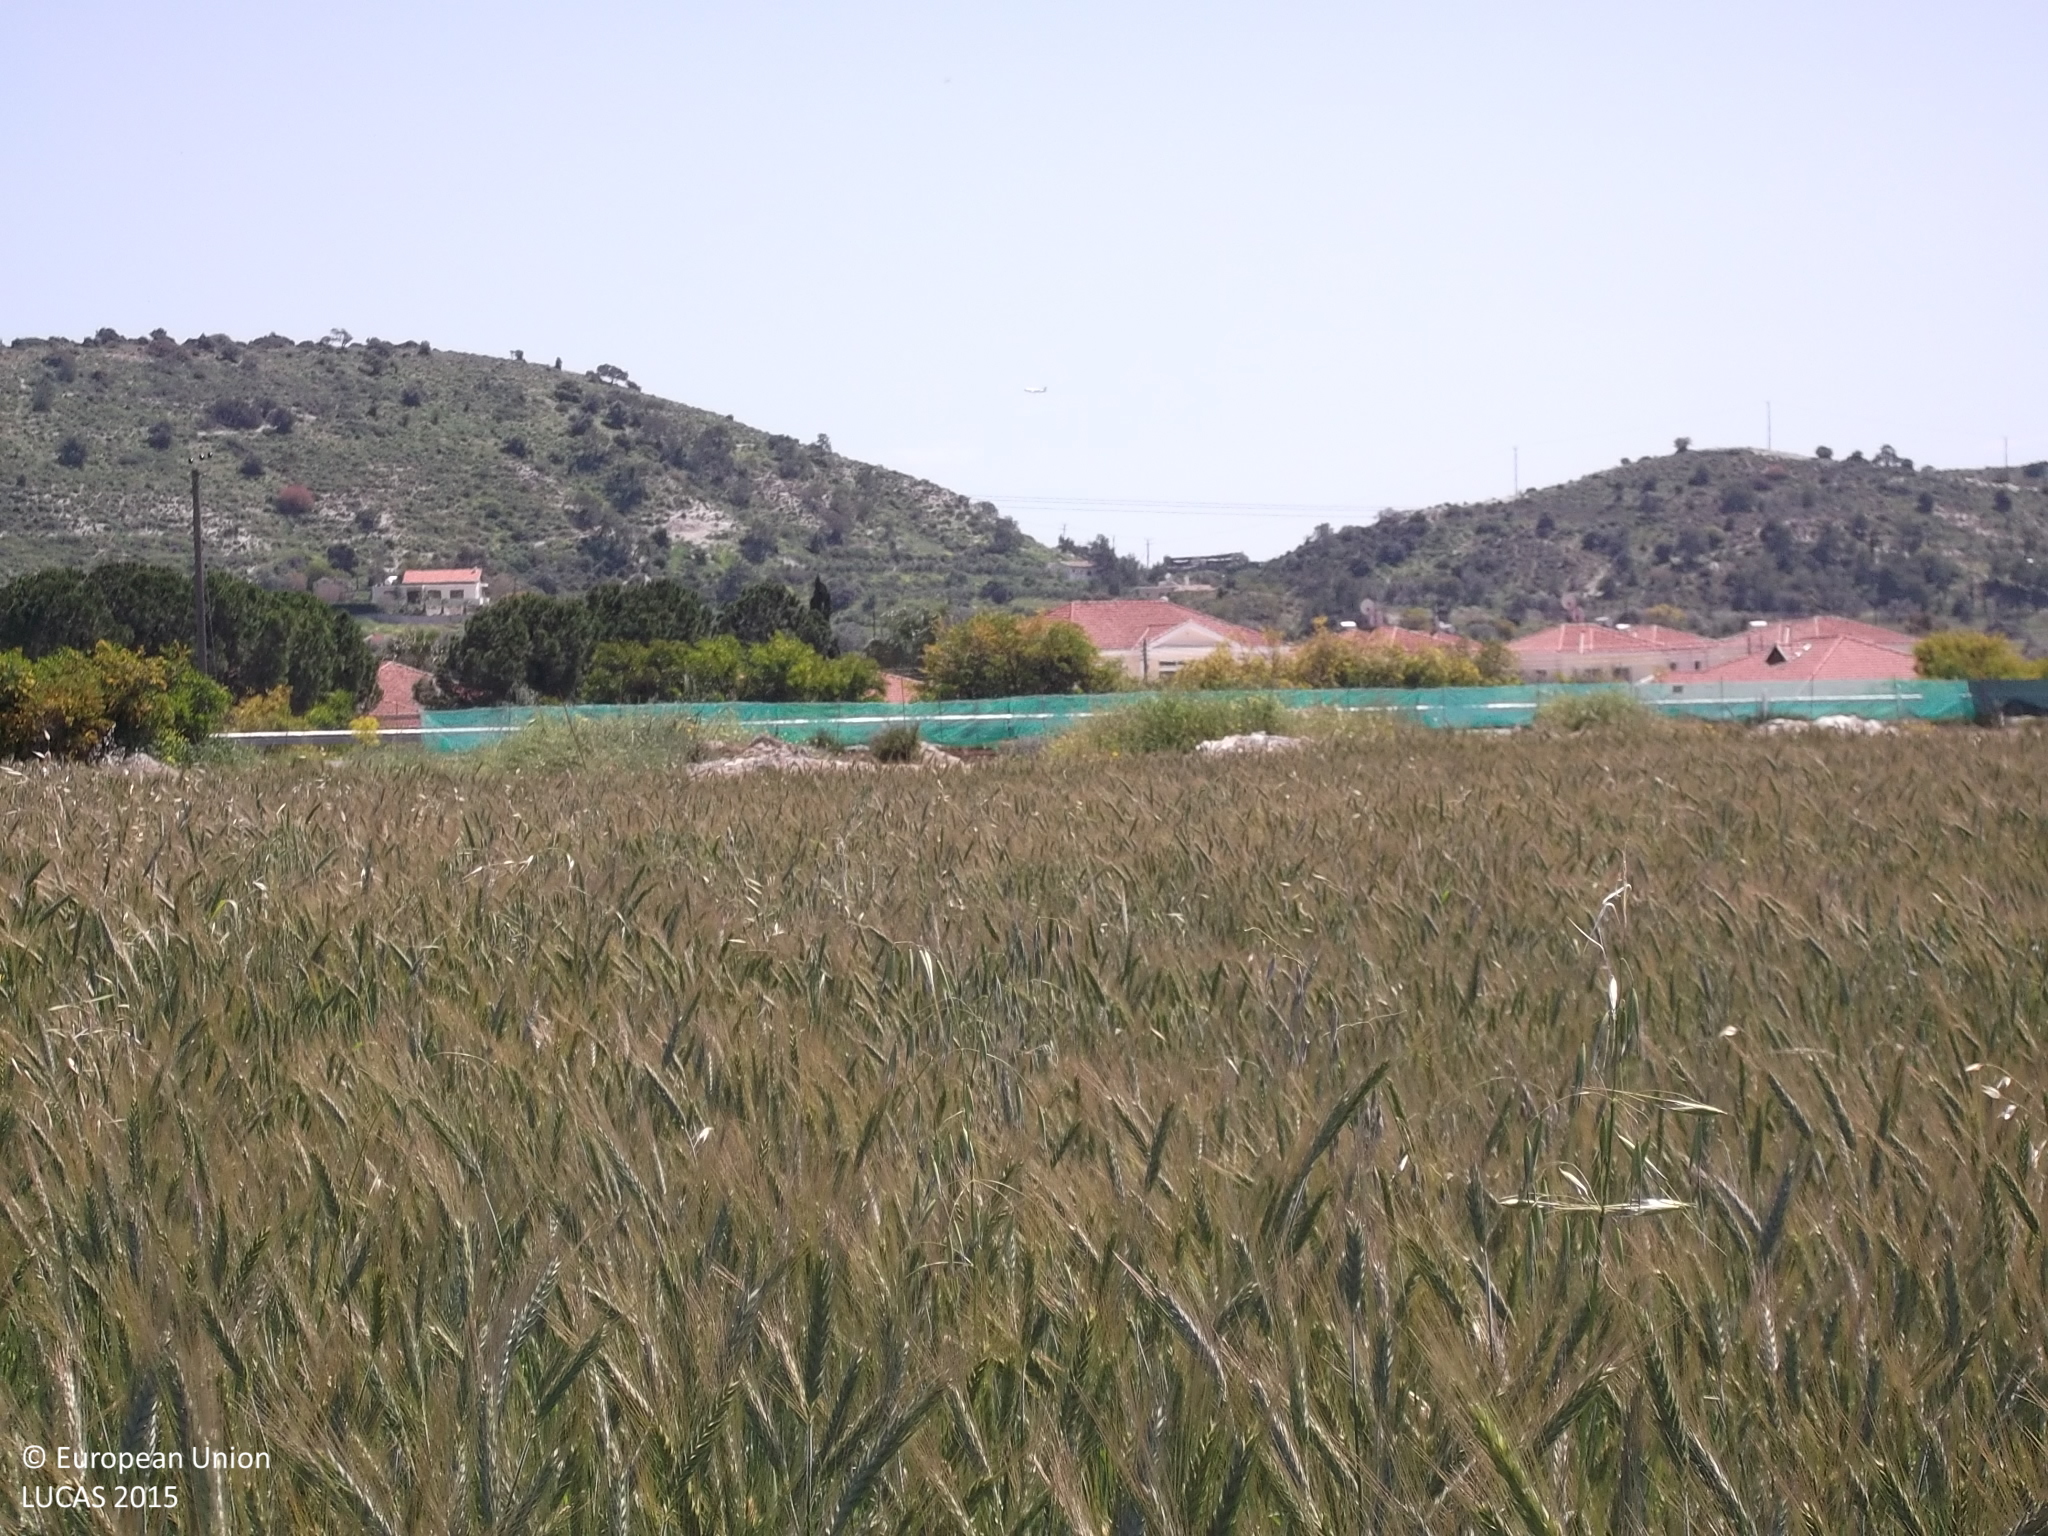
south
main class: Cropland
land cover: Common wheat
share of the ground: > 75 %
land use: Agriculture (excluding fallow land and kitchen gardens)
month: April
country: CY
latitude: 34.8706
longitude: 33.5018
